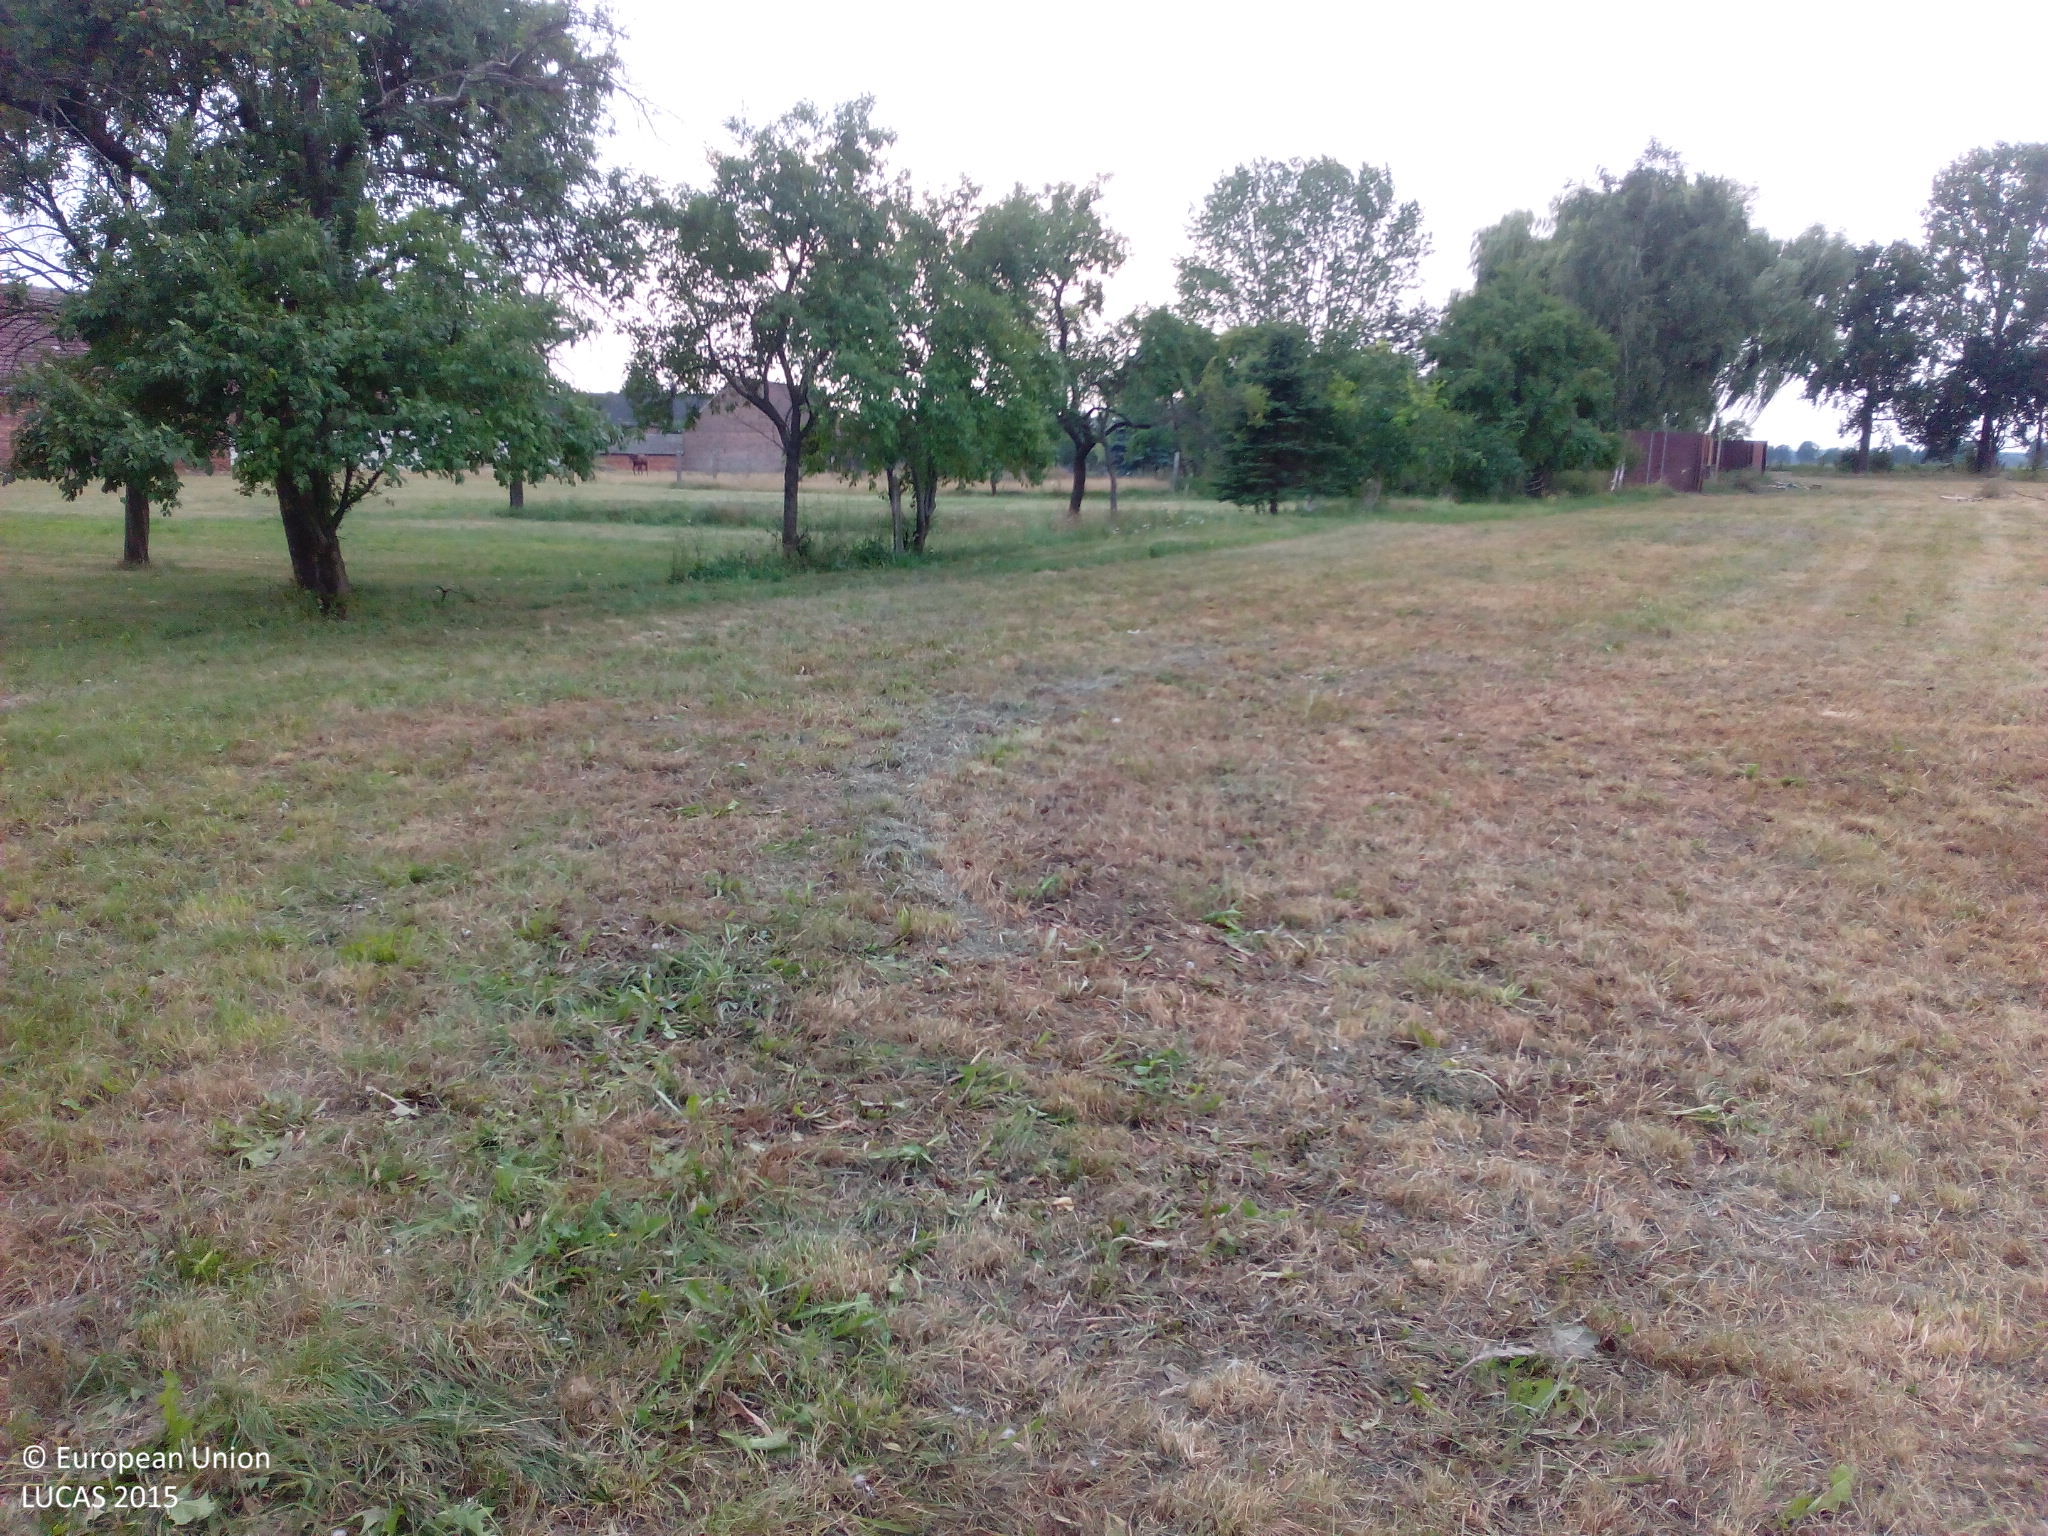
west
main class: Grassland
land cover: Grassland without tree/shrub cover
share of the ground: > 75 %
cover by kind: herbaceous plants 100 %
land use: Agriculture (excluding fallow land and kitchen gardens)
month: August
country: DE
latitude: 51.8141
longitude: 13.1478
